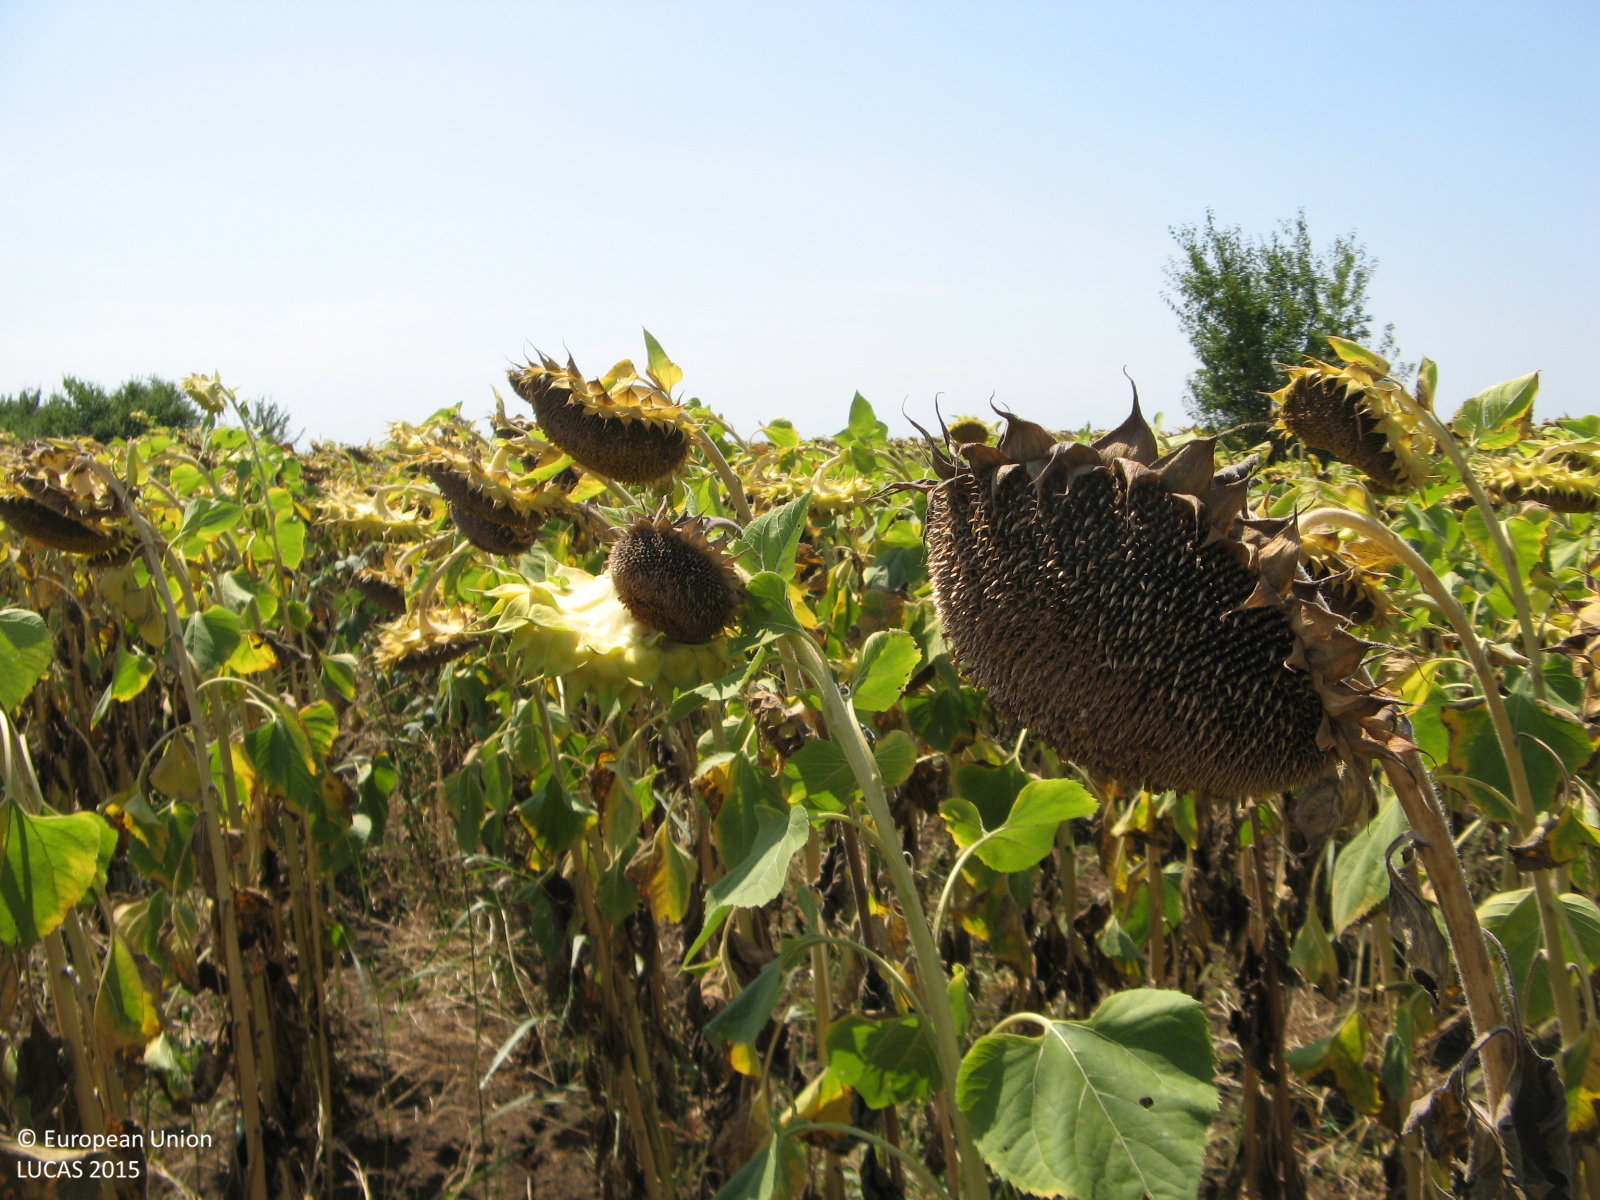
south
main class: Cropland
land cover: Sunflower
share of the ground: > 75 %
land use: Agriculture (excluding fallow land and kitchen gardens)
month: August
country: BG
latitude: 43.3879
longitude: 25.3222
